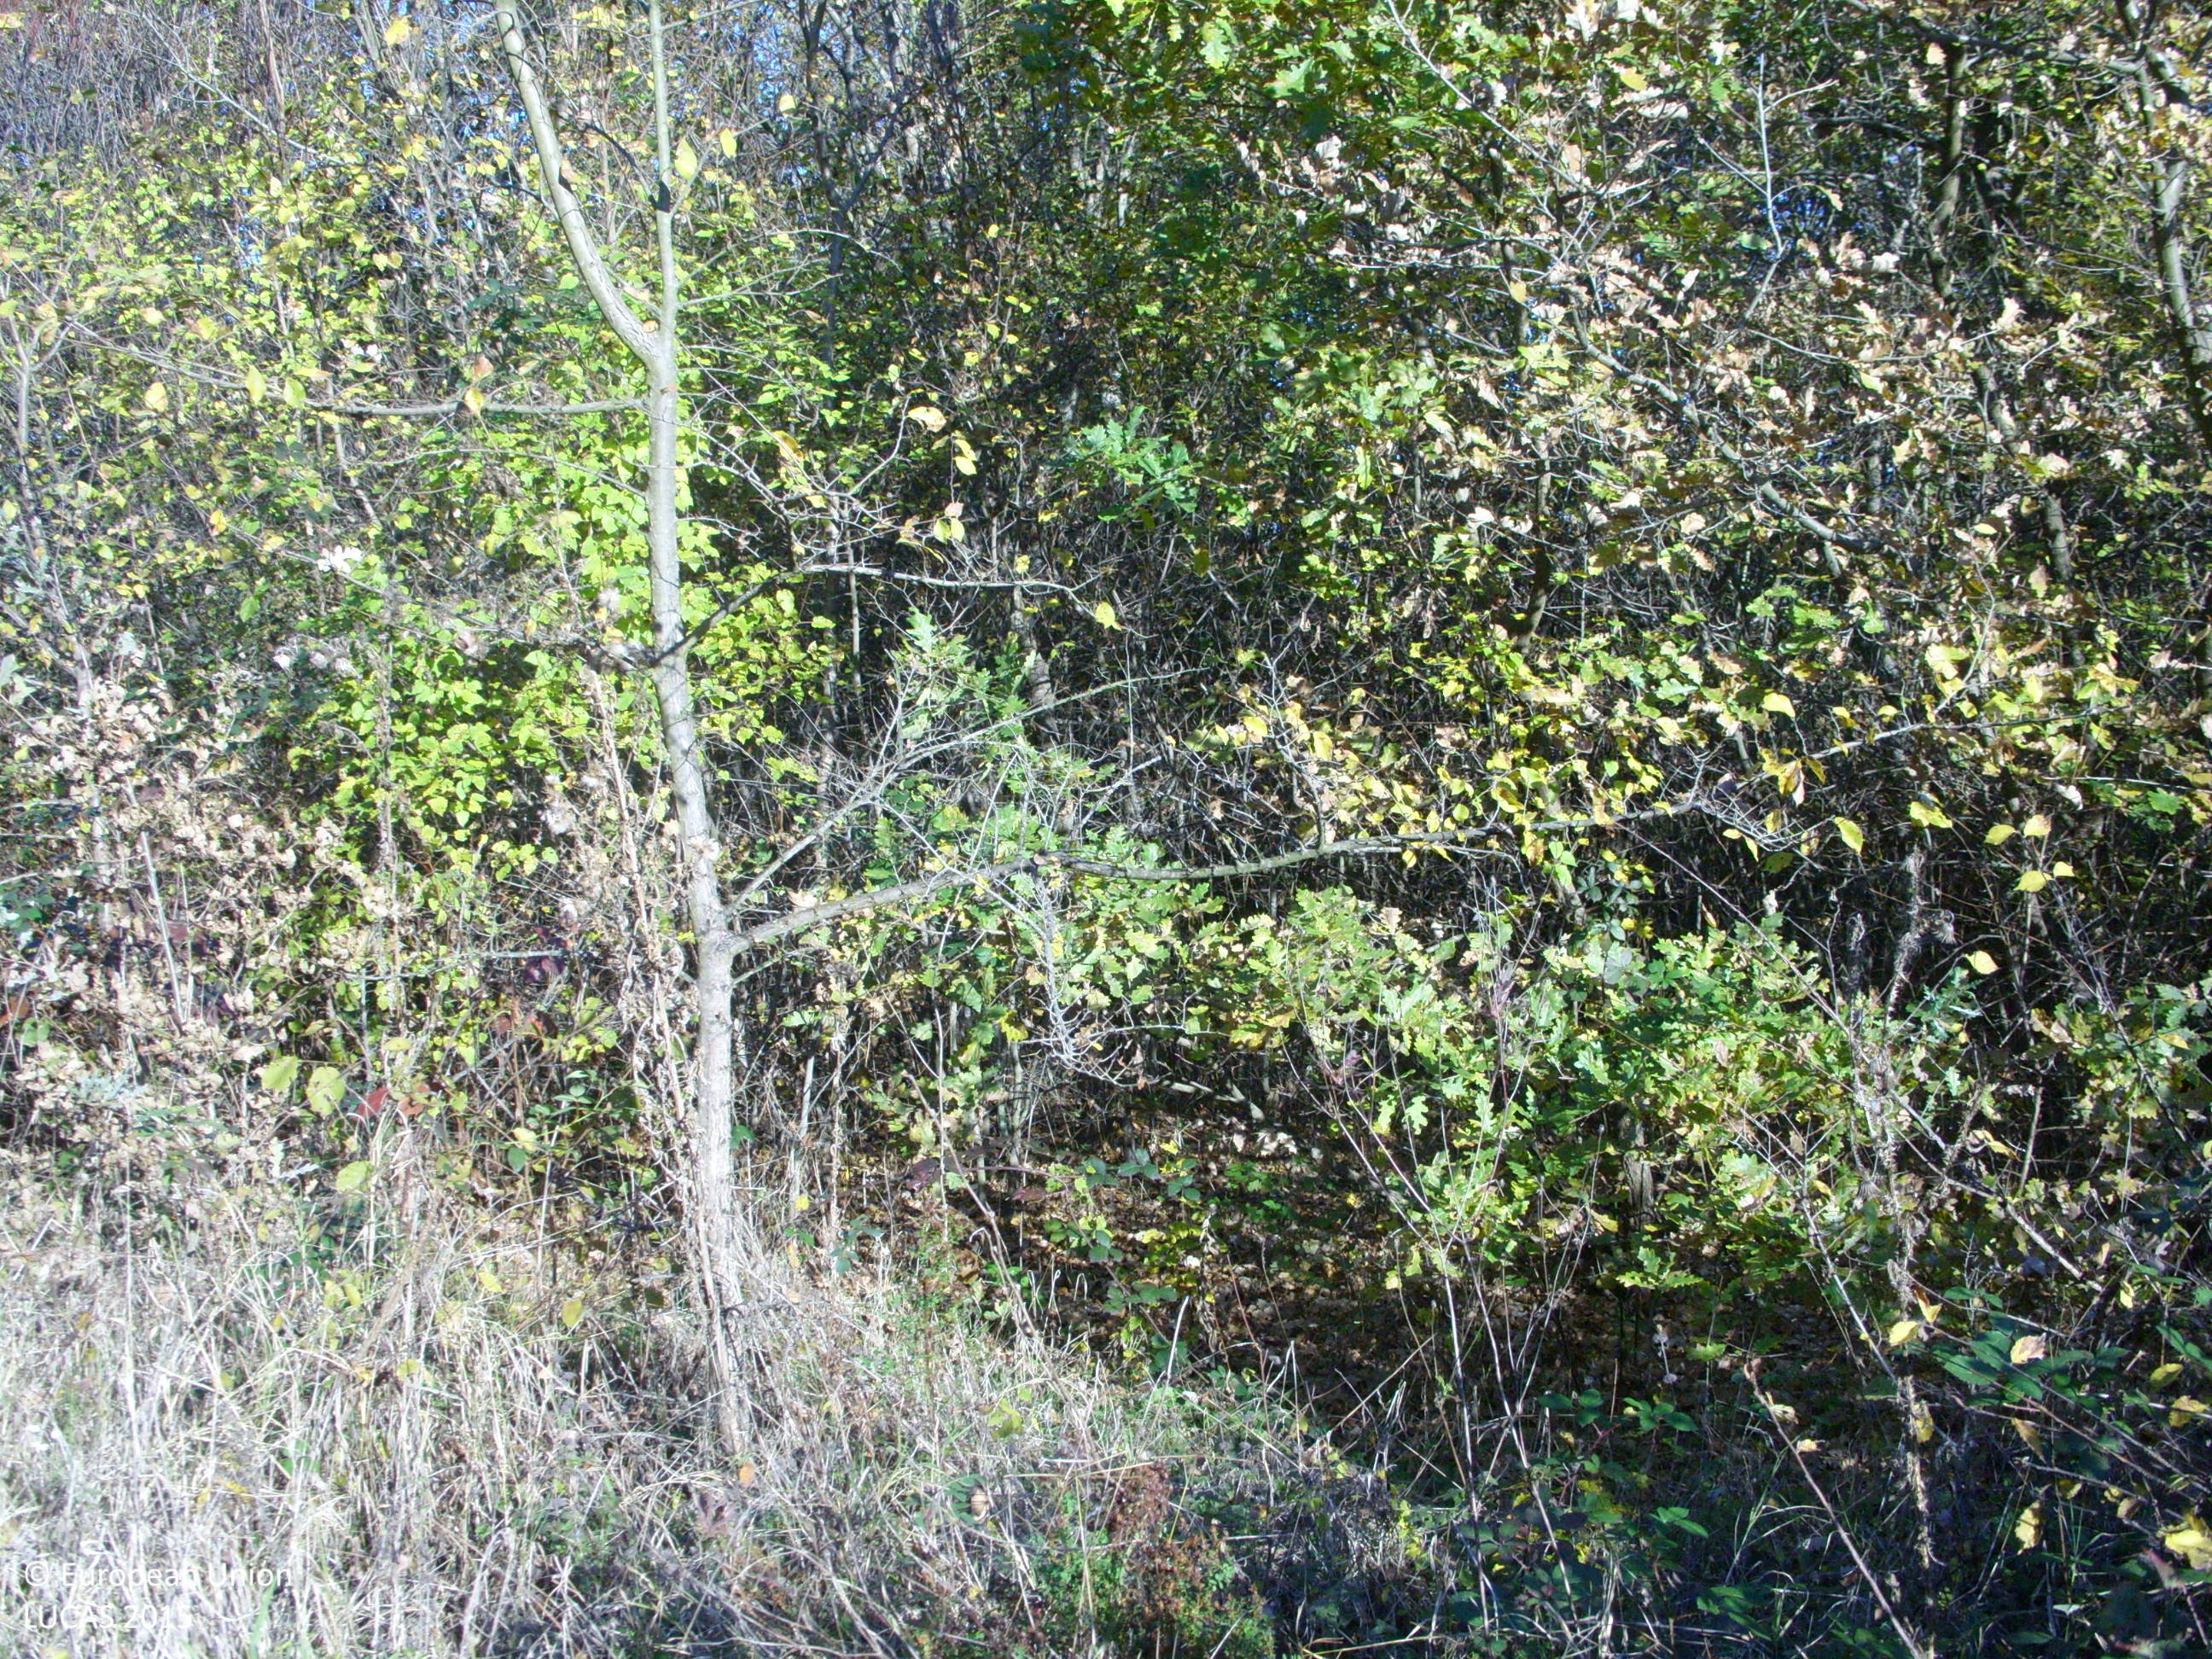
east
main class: Woodland
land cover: Broadleaved woodland
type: mesophytic deciduous forest
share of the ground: > 75 %
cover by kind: broadleaved forest trees 90 %, shrubs 5 %, unconsolidated bare surface 5 %
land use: Forestry
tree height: > 5 m
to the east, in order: Broadleaved woodland; Grass margins; Tracks; Broadleaved woodland; Tracks; Grass margins; Broadleaved woodland
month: November
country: BG
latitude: 42.4005
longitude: 24.8170
